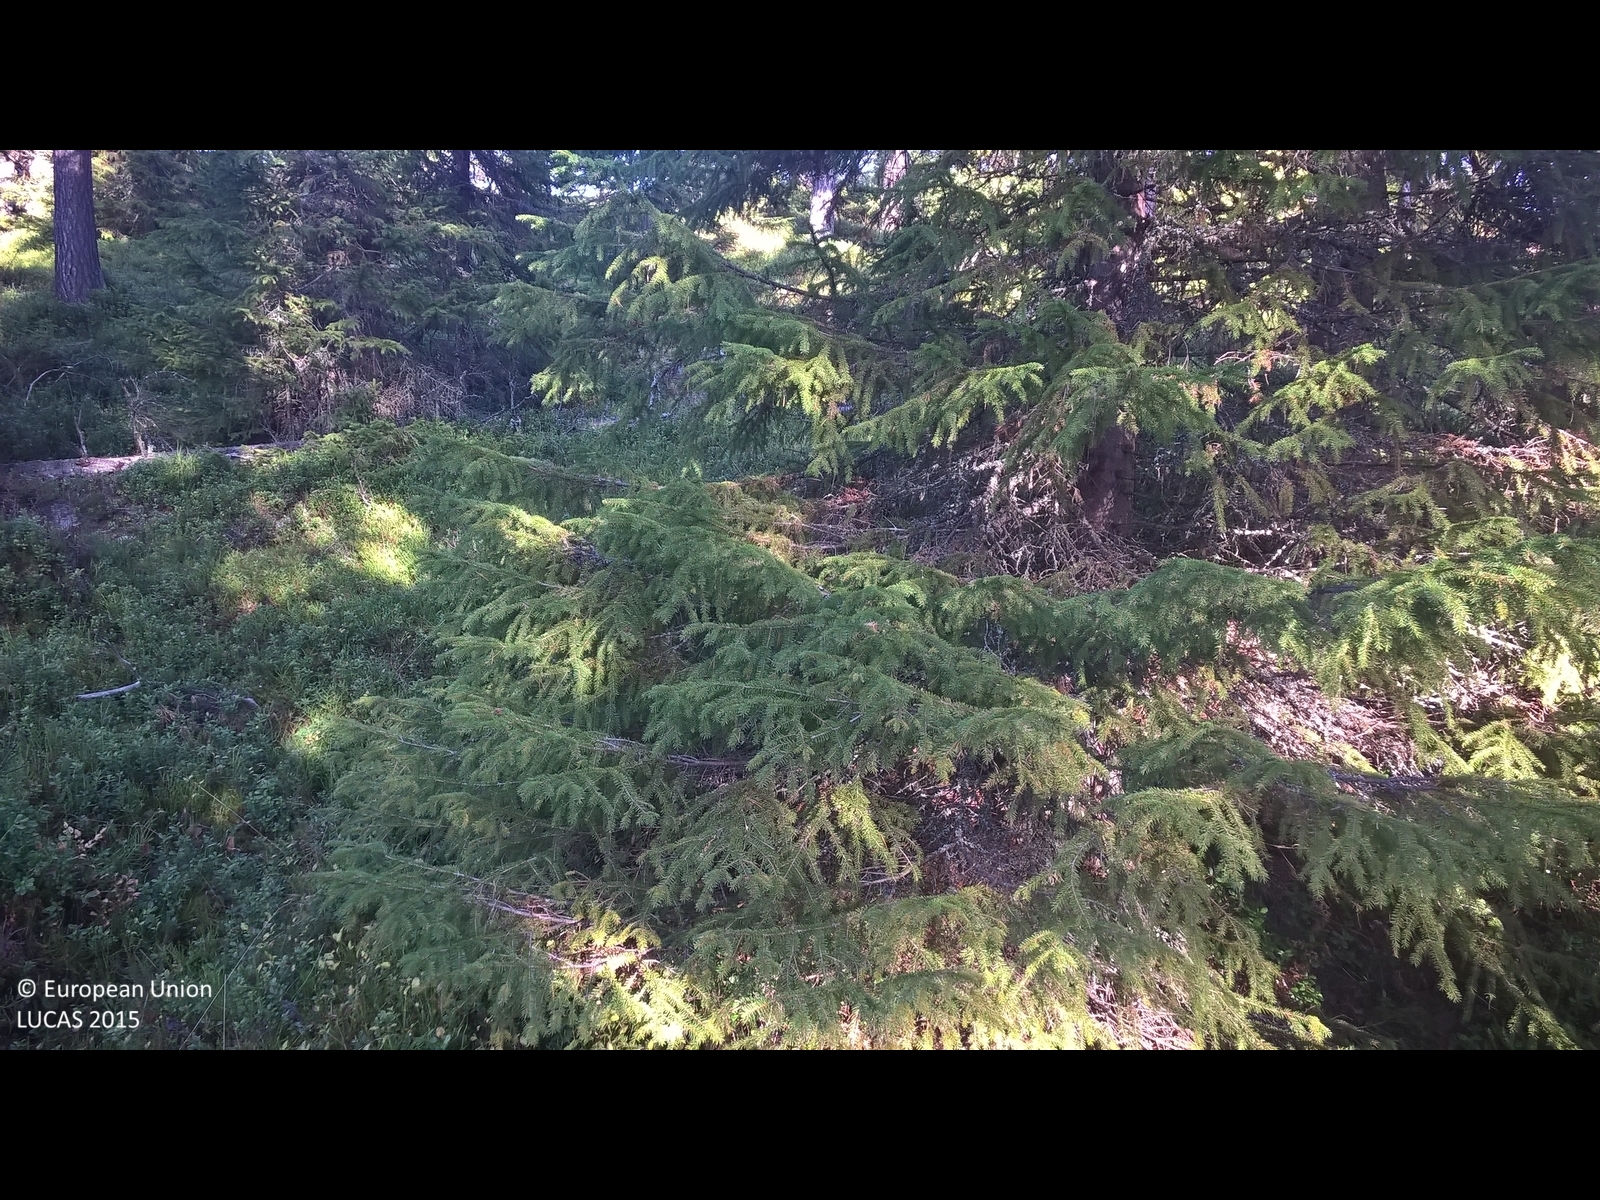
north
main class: Woodland
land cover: Spruce dominated coniferous woodland
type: boreal forest
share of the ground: 50 - 75 %
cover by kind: coniferous forest trees 70 %, lichens and mosses 30 %
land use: Forestry
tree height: > 5 m
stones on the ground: < 10 %
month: October
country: SE
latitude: 63.3285
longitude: 13.5563
